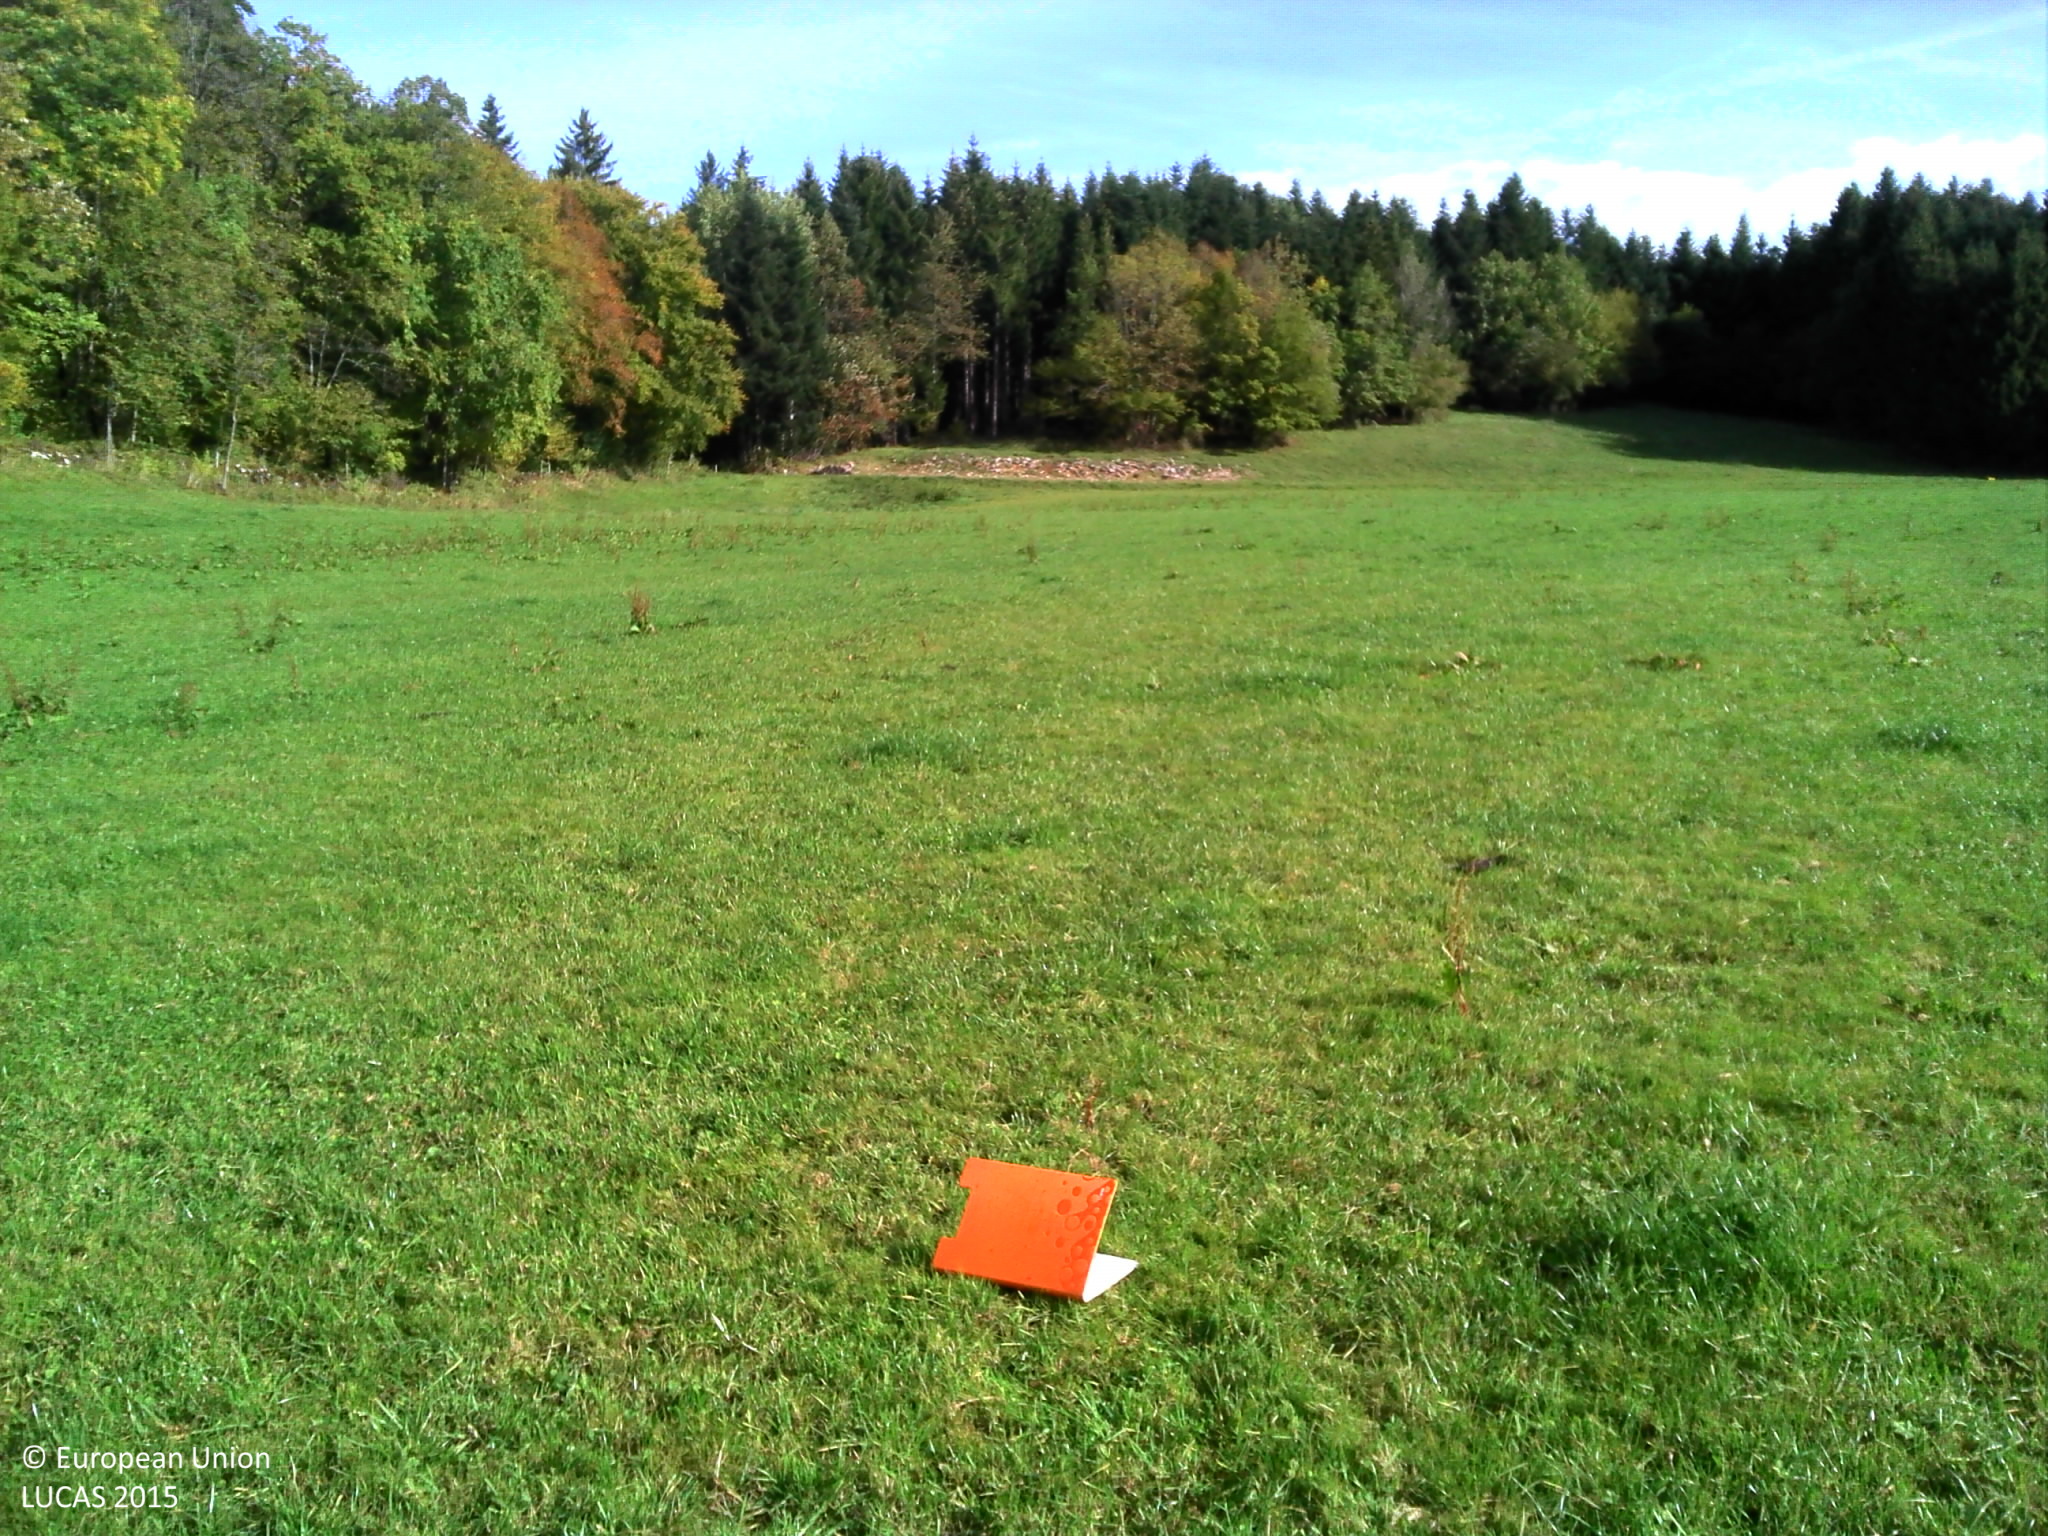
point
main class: Grassland
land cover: Grassland without tree/shrub cover
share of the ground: > 75 %
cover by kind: herbaceous plants 100 %
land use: Agriculture (excluding fallow land and kitchen gardens)
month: October
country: FR
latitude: 47.0625
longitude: 6.3024
